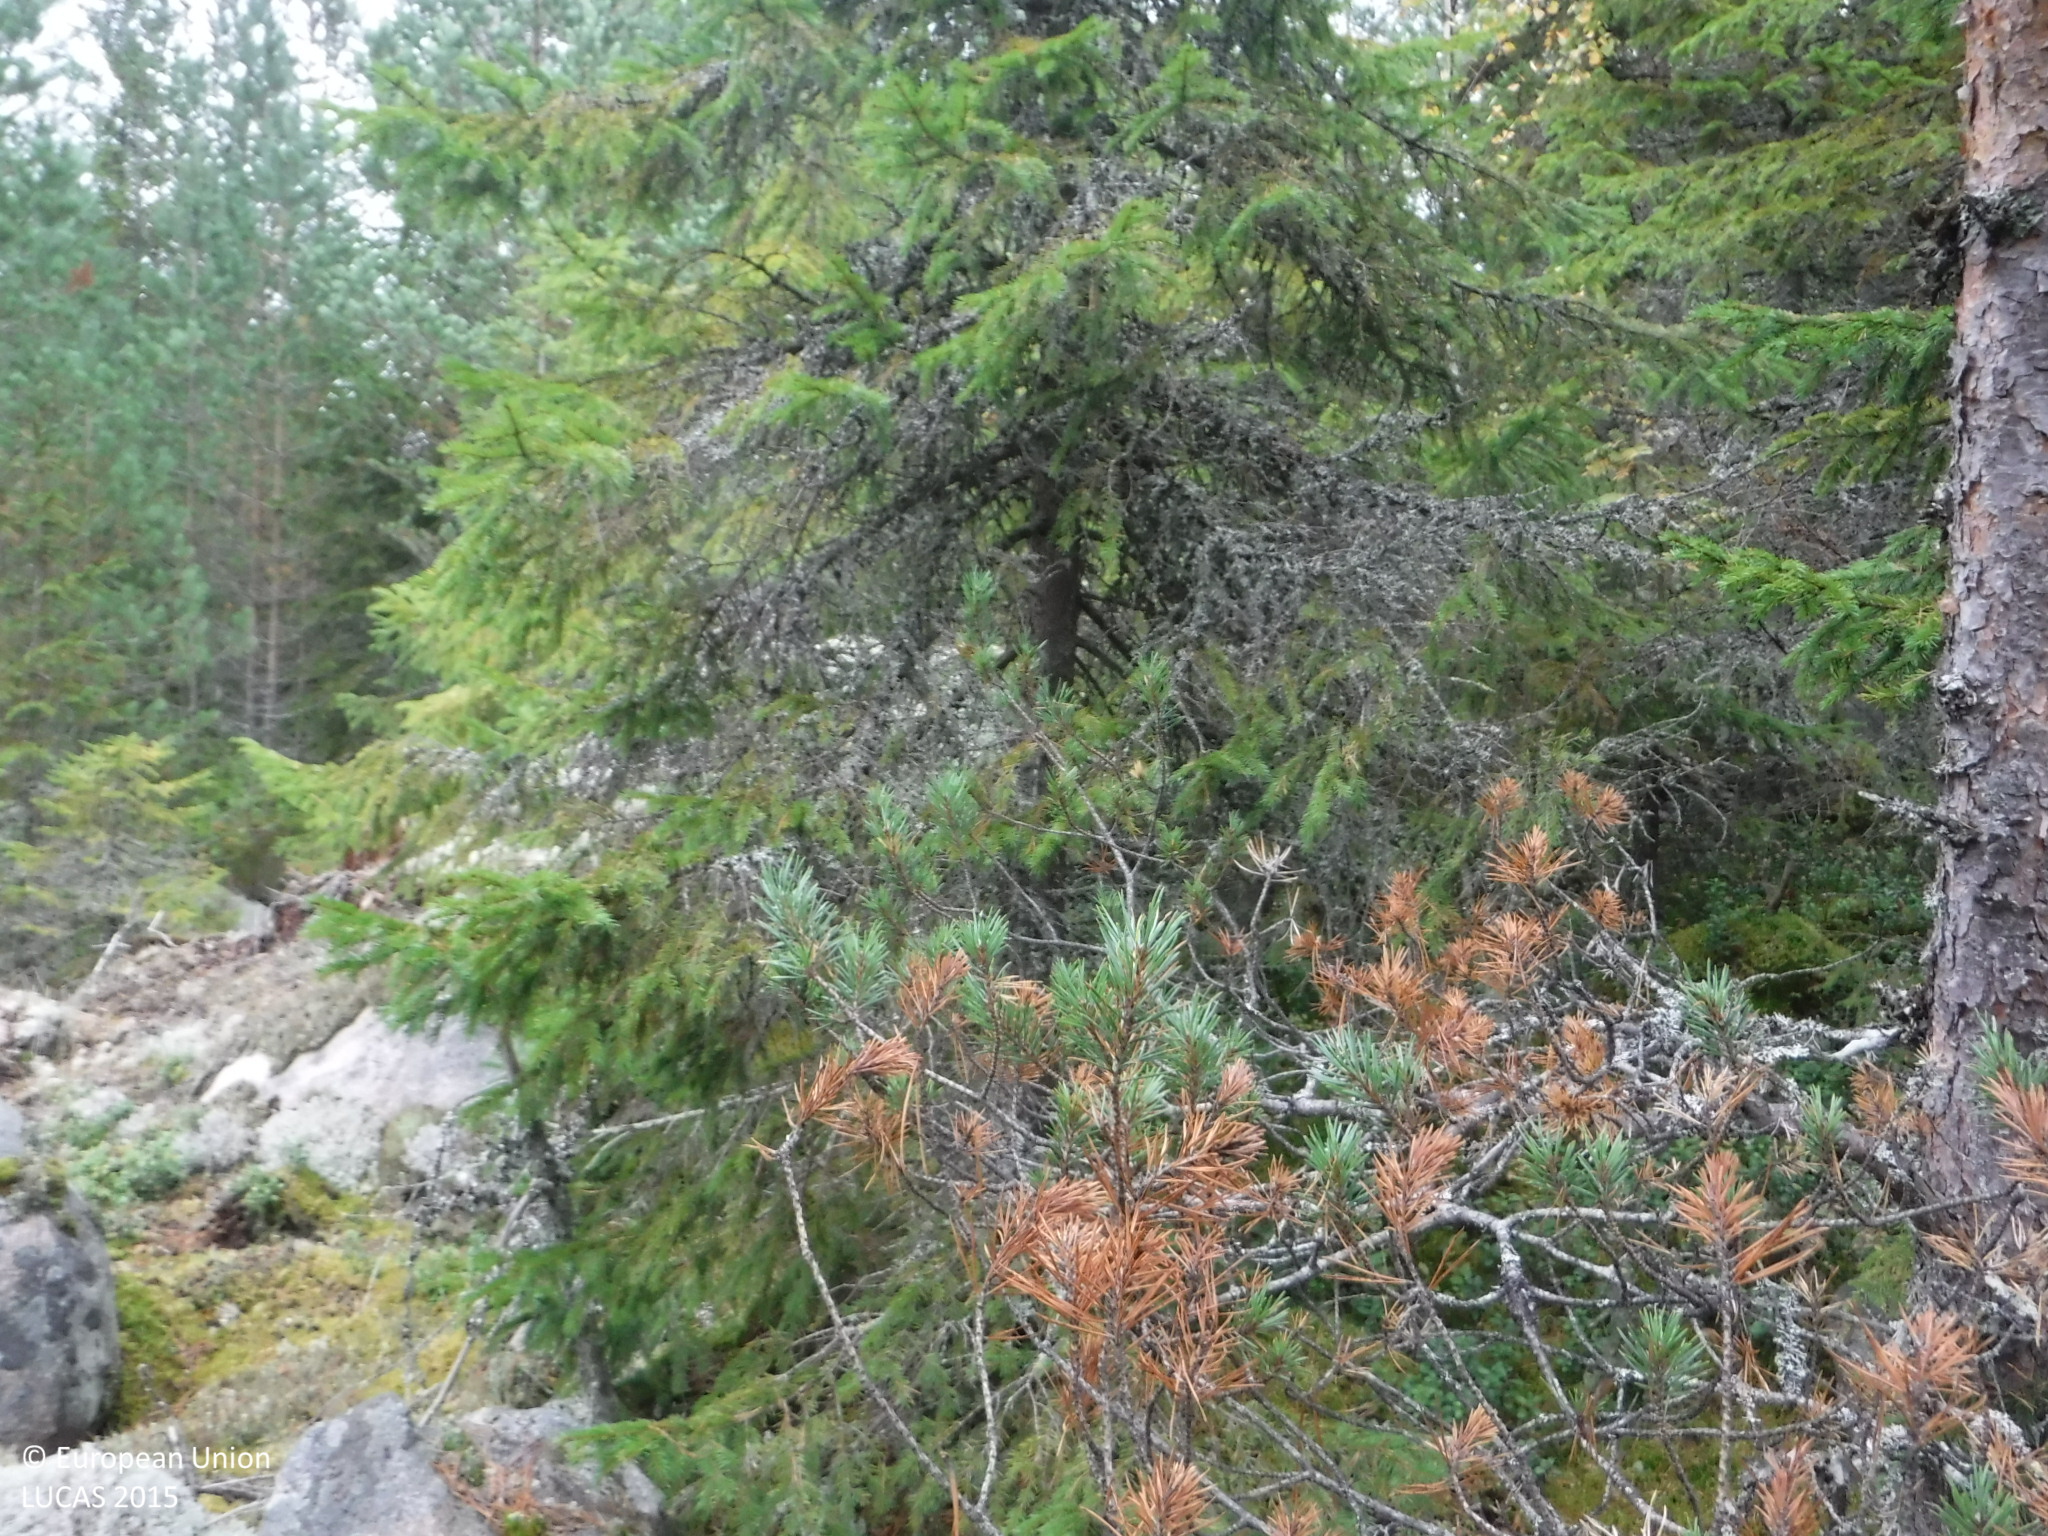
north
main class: Woodland
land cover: Other coniferous woodland
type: boreal forest
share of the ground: 50 - 75 %
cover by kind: coniferous forest trees 55 %, lichens and mosses 25 %, shrubs 20 %
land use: Forestry
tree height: > 5 m
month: September
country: FI
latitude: 61.5752
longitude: 23.9282
